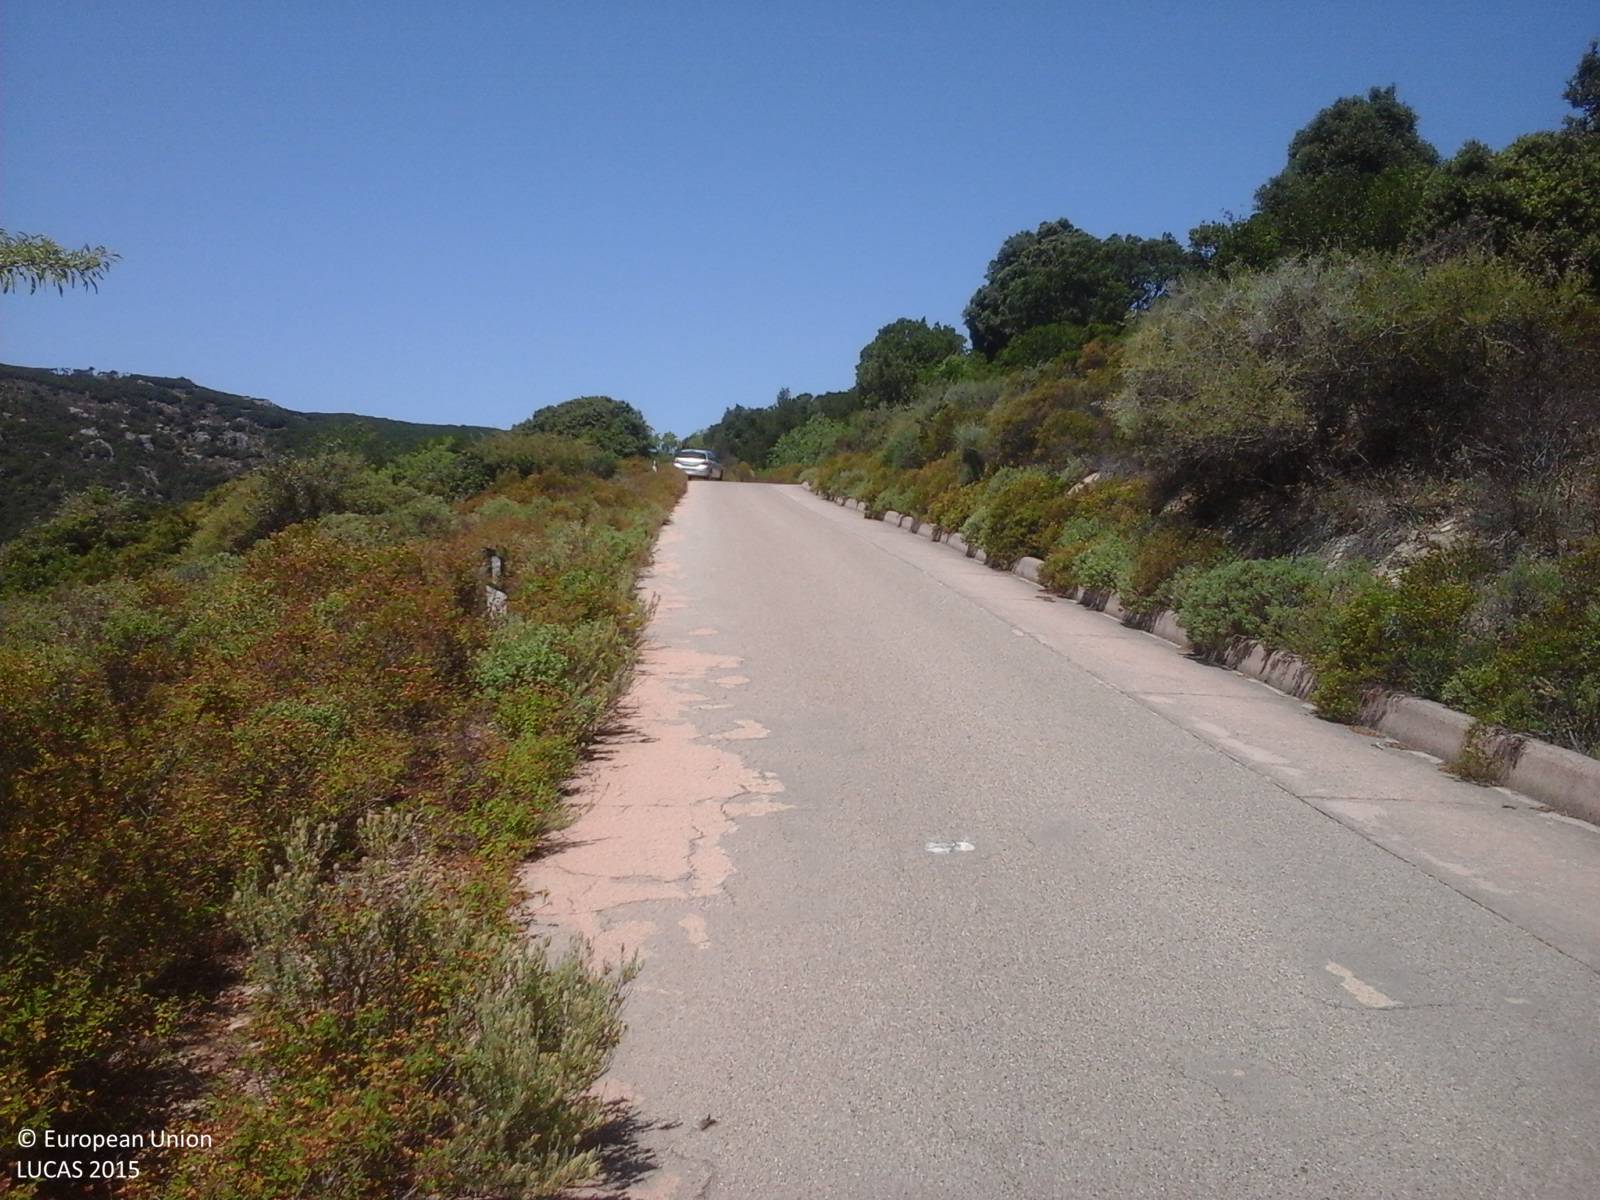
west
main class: Shrubland
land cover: Shrubland with sparse tree cover
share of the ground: > 75 %
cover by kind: shrubs 55 %, herbaceous plants 30 %, unconsolidated bare surface 10 %, broadleaved forest trees 5 %
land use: Semi-natural and natural areas not in use
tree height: < 5 m
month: June
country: IT
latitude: 39.2513
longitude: 9.4127
